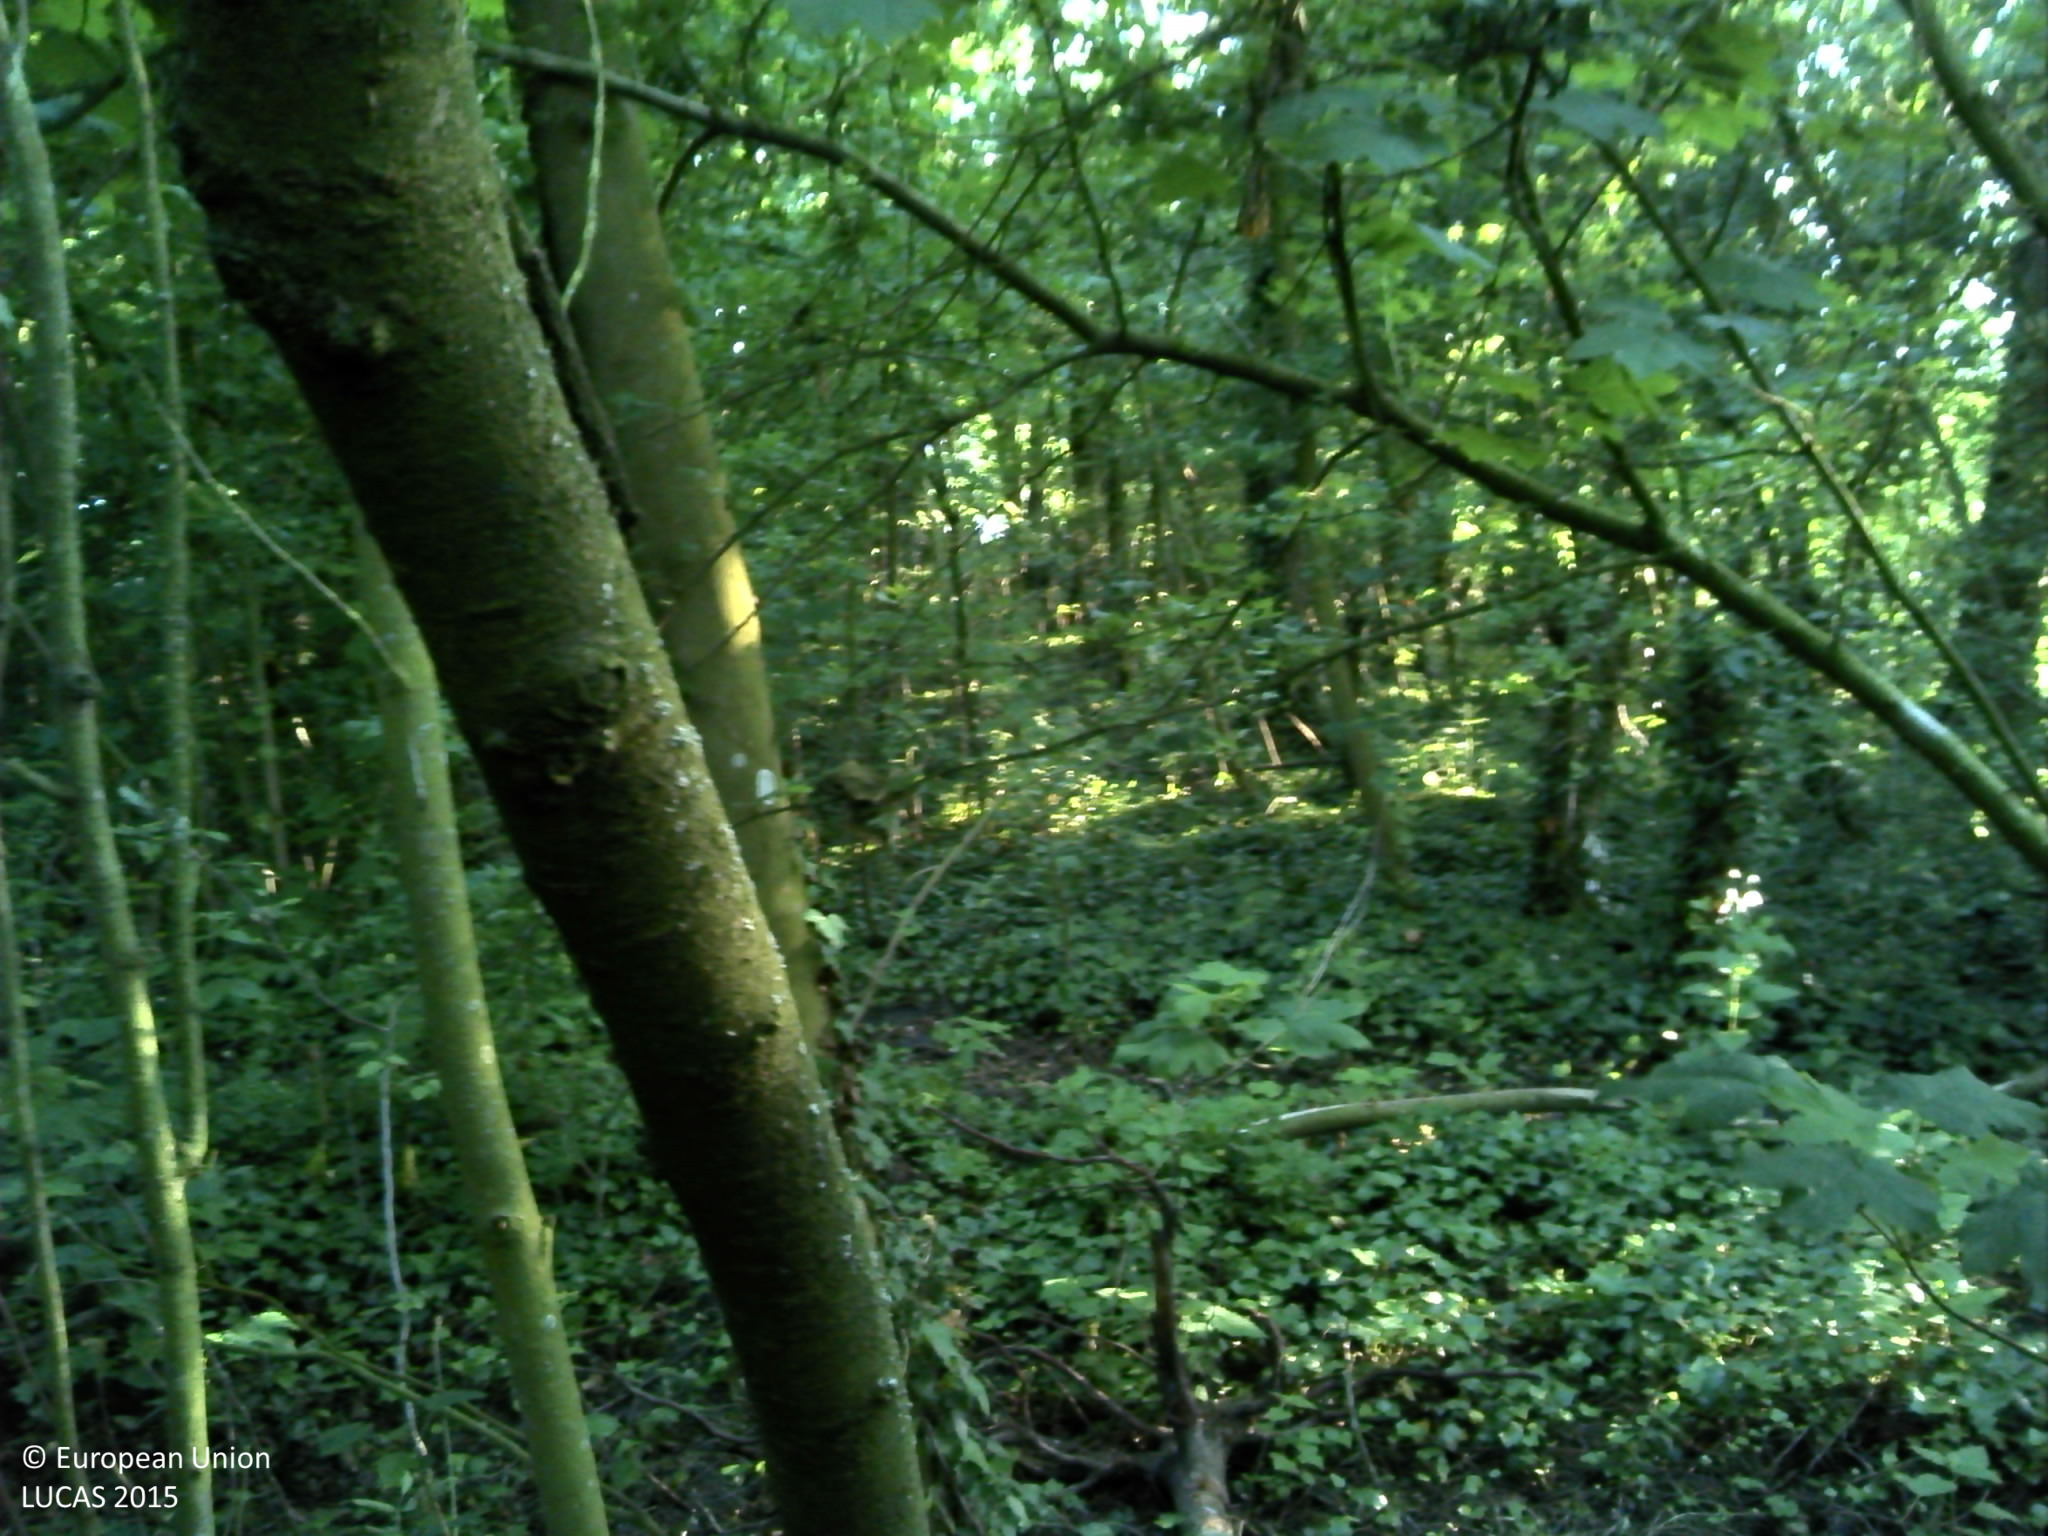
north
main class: Woodland
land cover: Broadleaved woodland
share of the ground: > 75 %
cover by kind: broadleaved forest trees 80 %, herbaceous plants 20 %
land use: Forestry
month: June
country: FR
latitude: 49.6746
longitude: 1.1235
